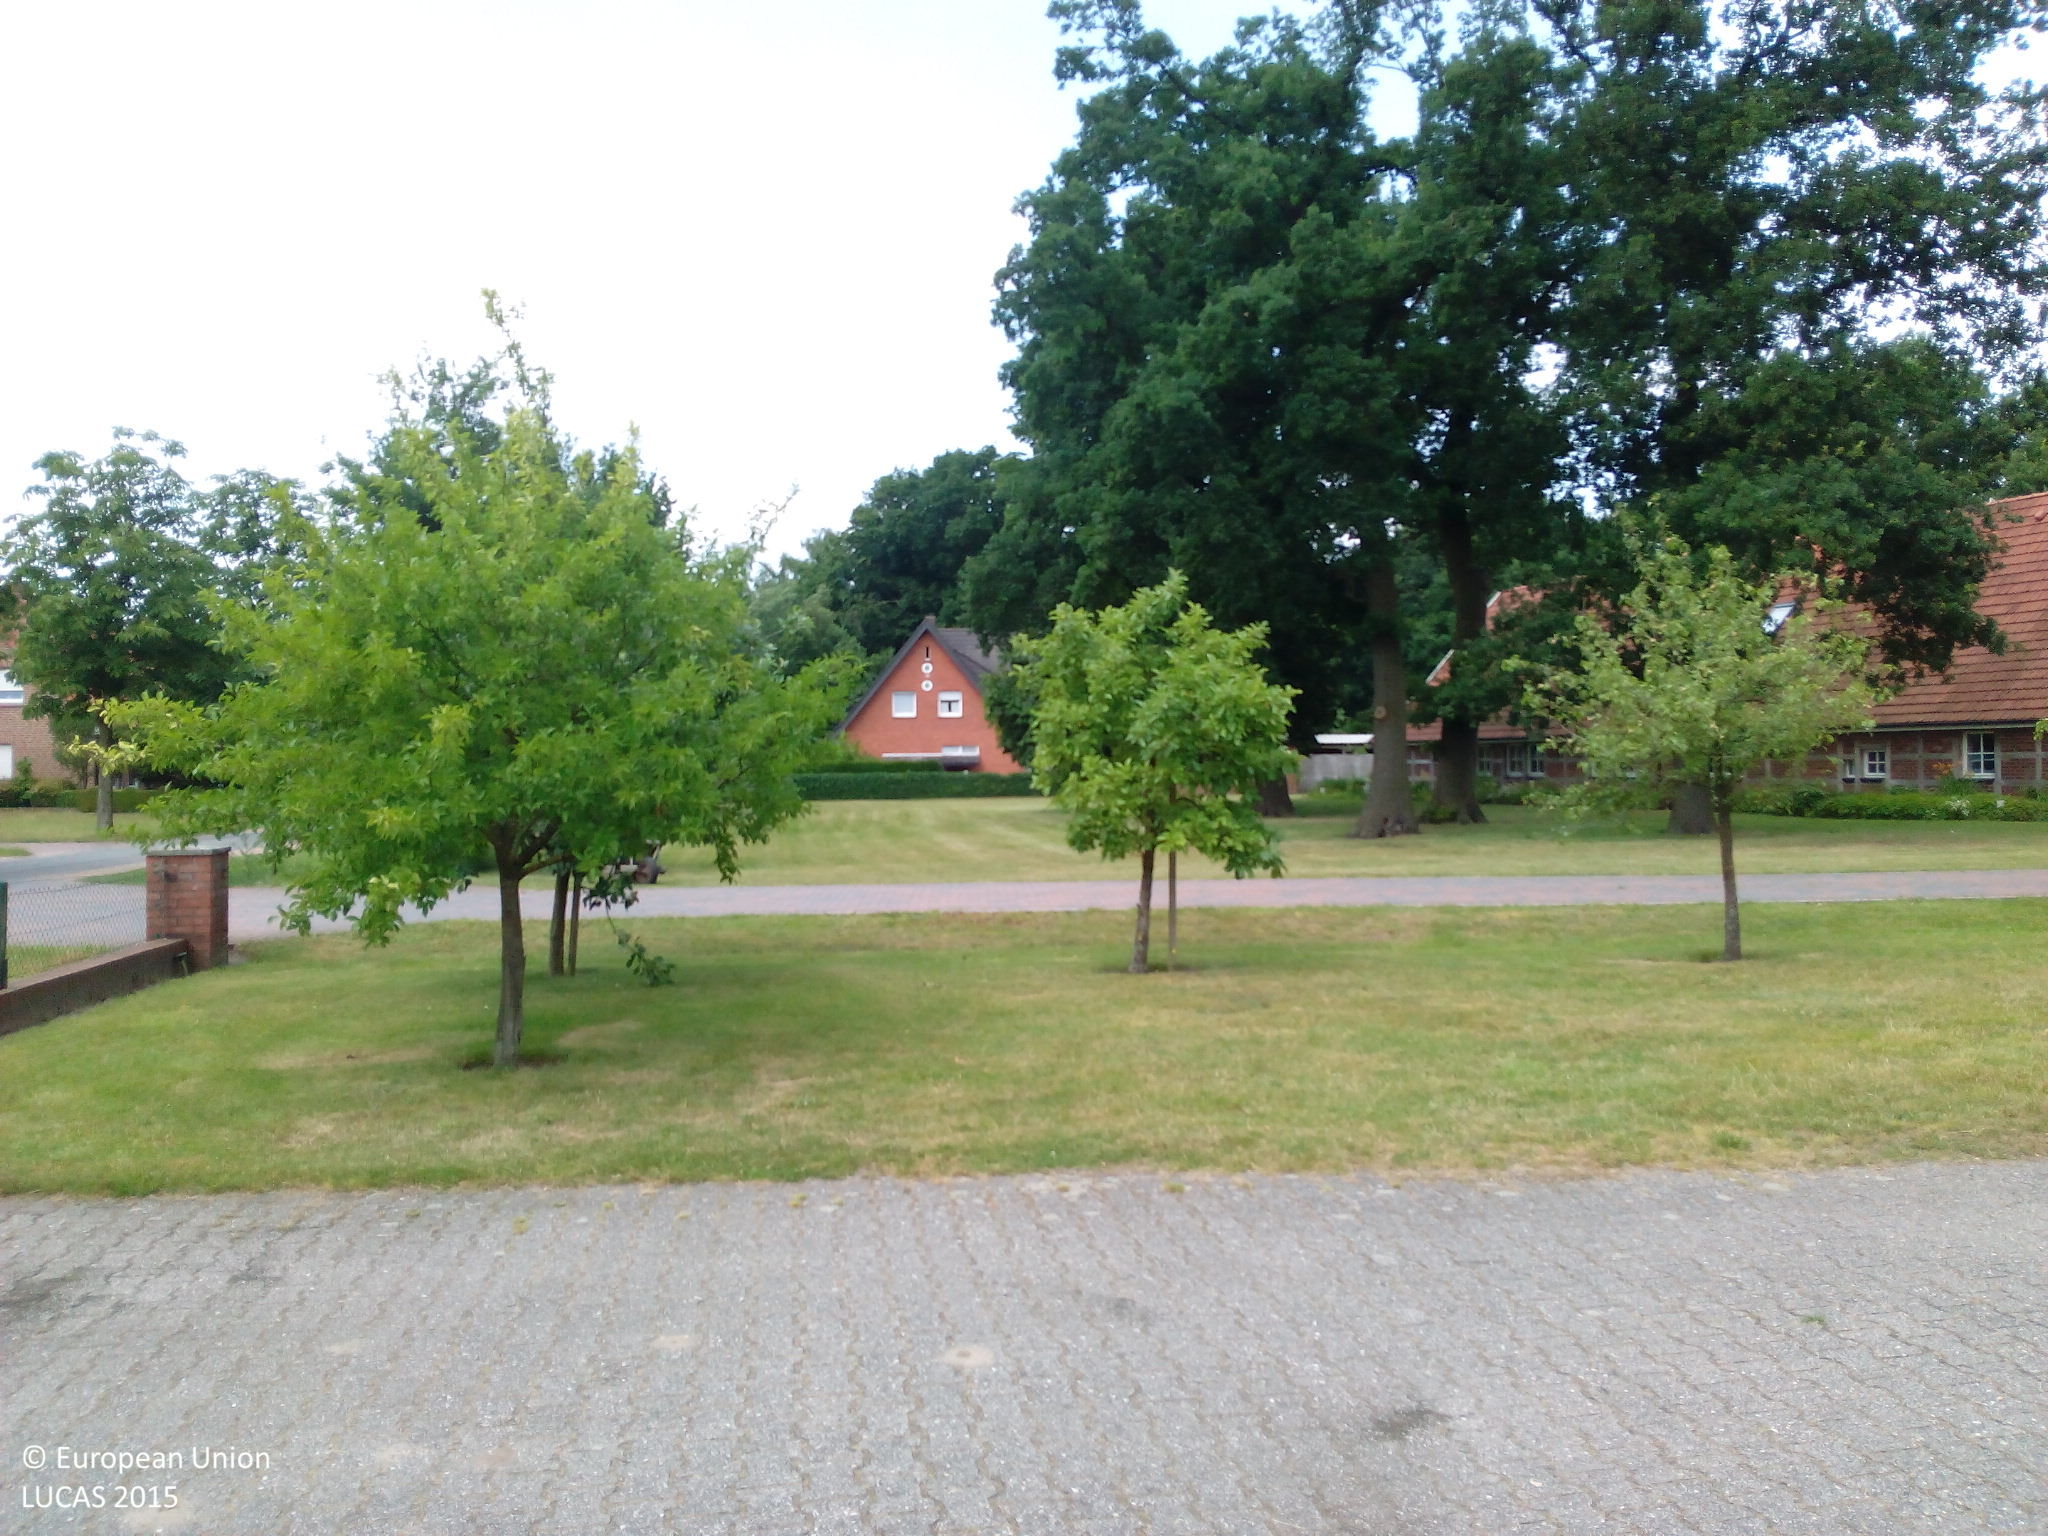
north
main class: Grassland
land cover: Grassland without tree/shrub cover
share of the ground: > 75 %
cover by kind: herbaceous plants 100 %
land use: Residential
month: July
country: DE
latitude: 52.6717
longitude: 7.3532
